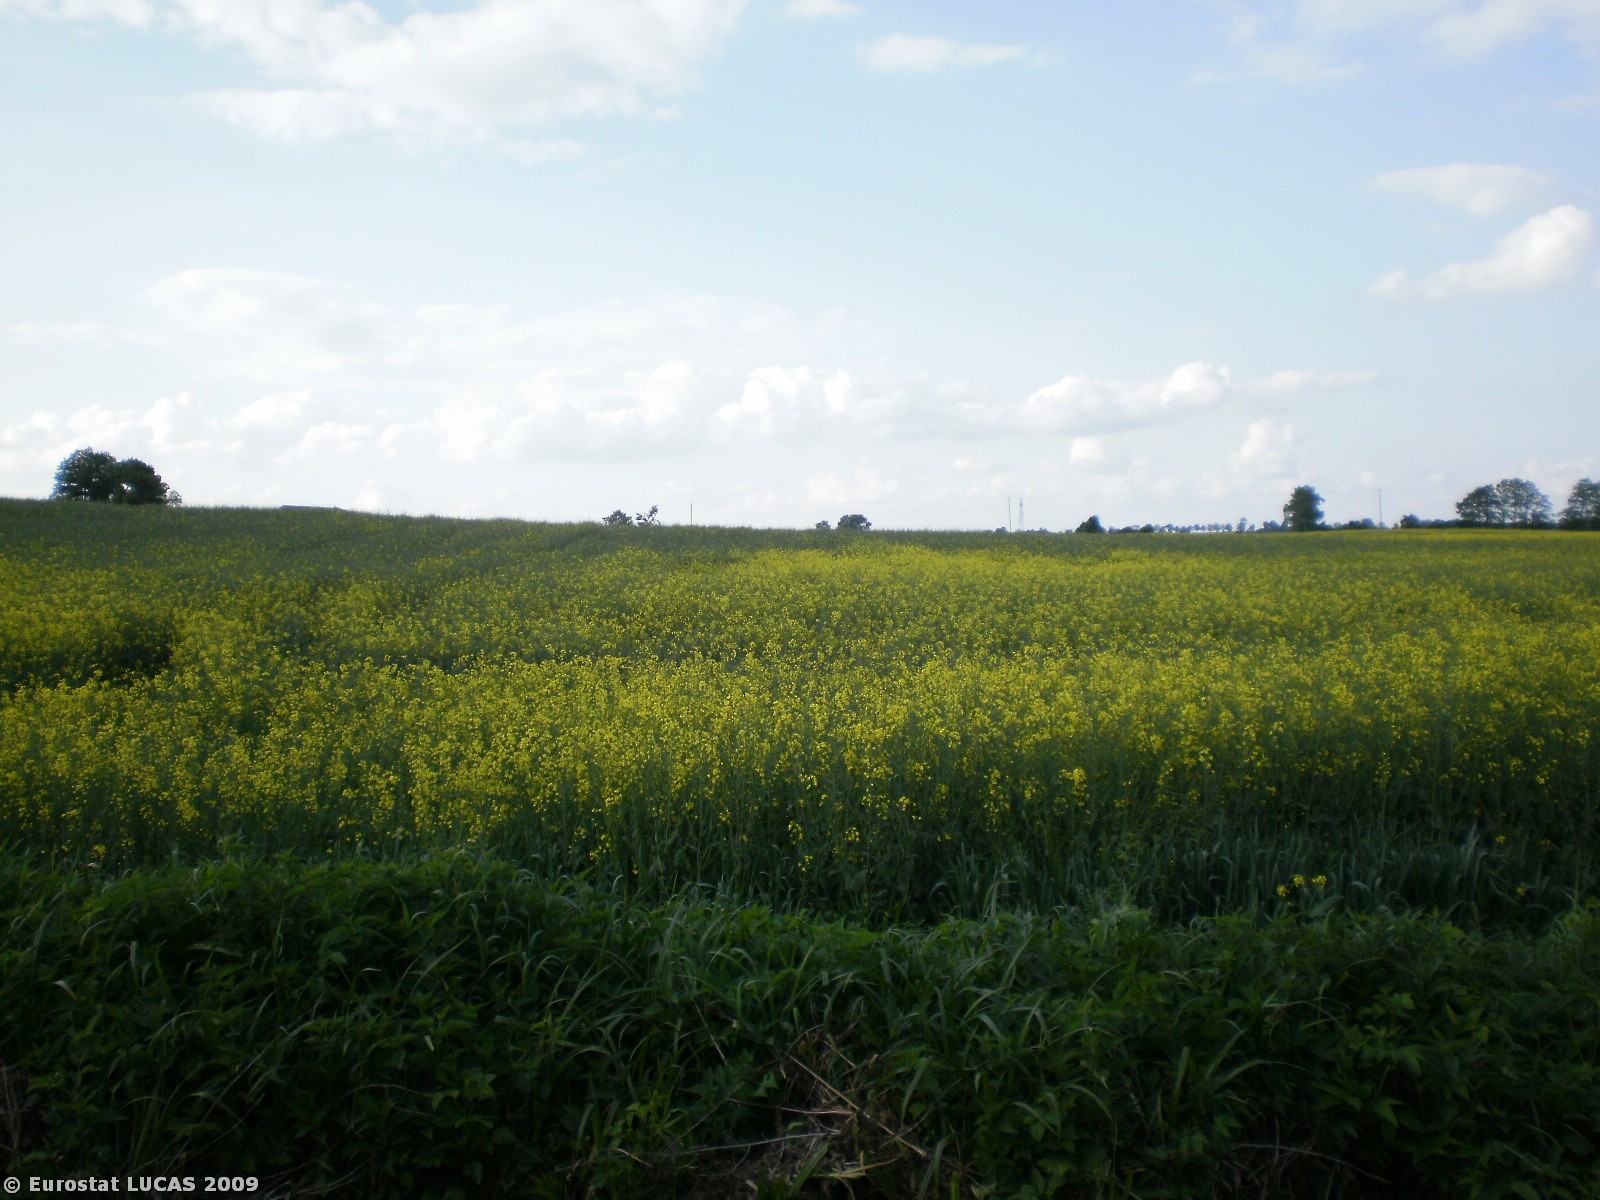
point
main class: Cropland
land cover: Rape and turnip rape
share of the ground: > 75 %
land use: Agriculture (excluding fallow land and kitchen gardens)
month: May
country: PL
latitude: 53.3361
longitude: 17.7172
